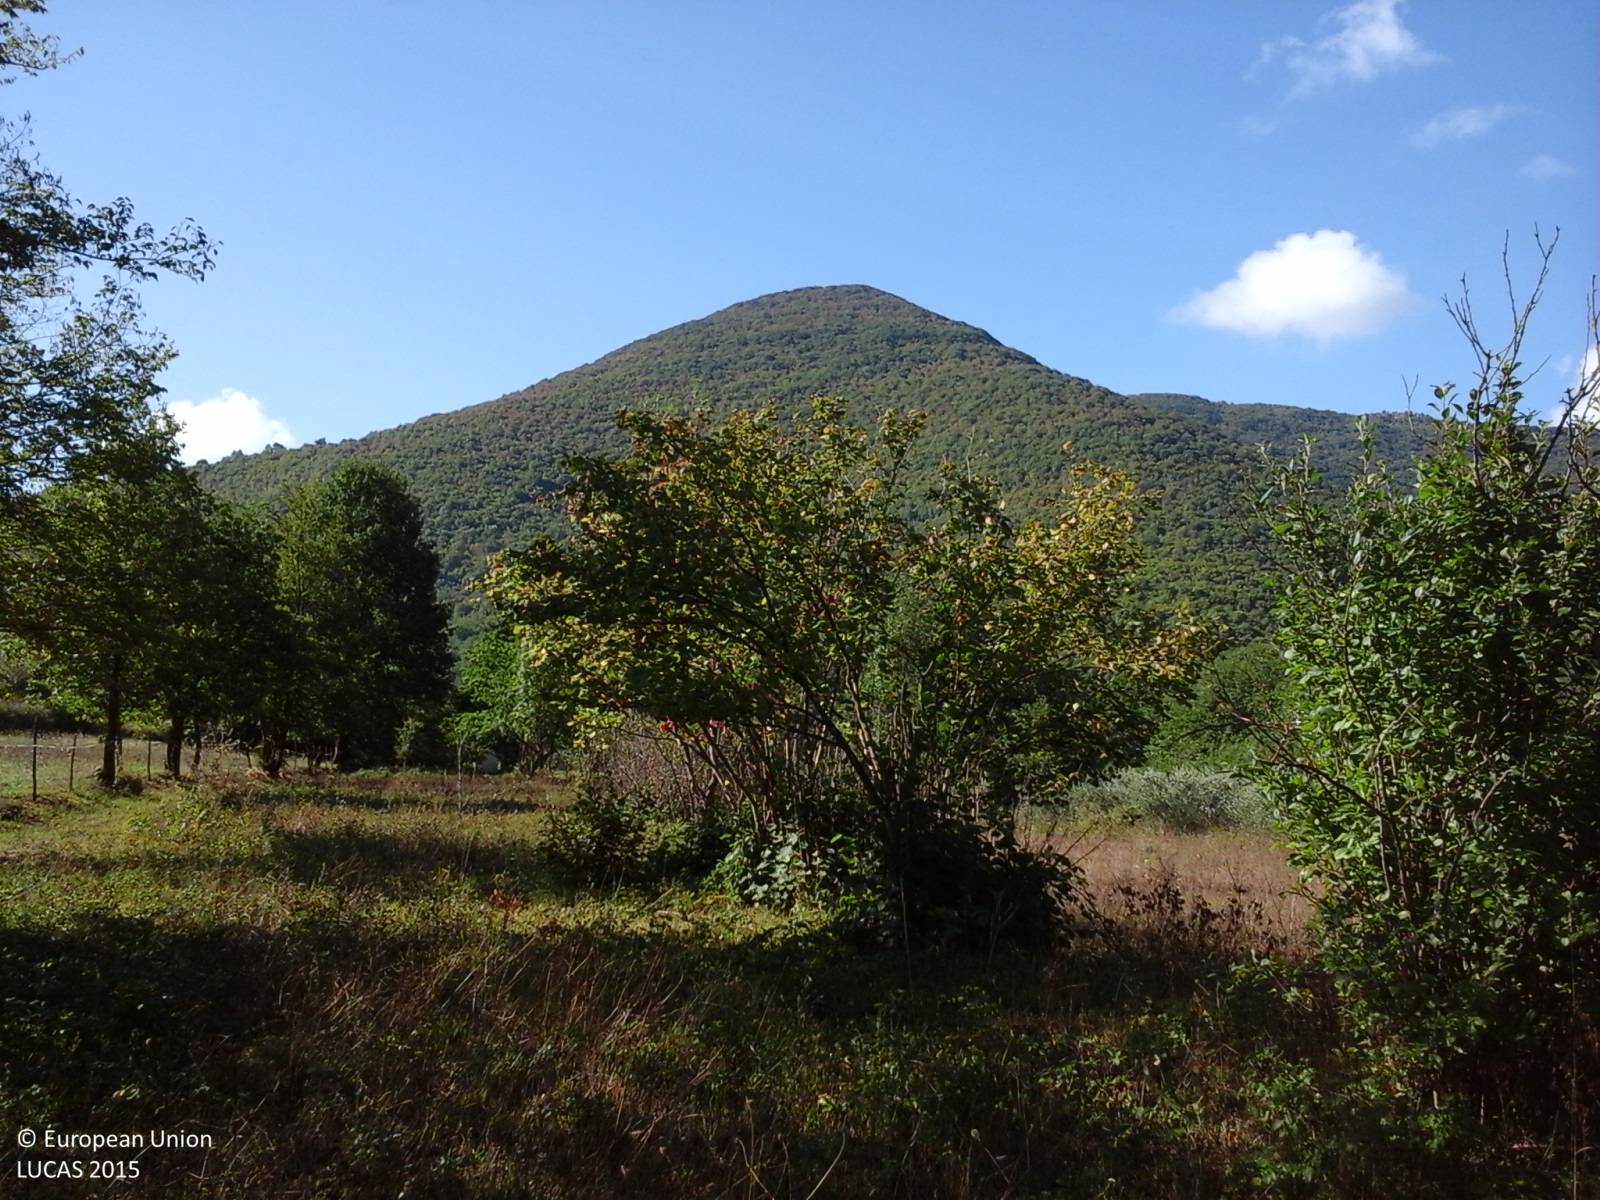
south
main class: Grassland
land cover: Grassland without tree/shrub cover
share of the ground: > 75 %
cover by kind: herbaceous plants 100 %
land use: Agriculture (excluding fallow land and kitchen gardens)
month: August
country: IT
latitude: 41.4216
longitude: 13.3967
